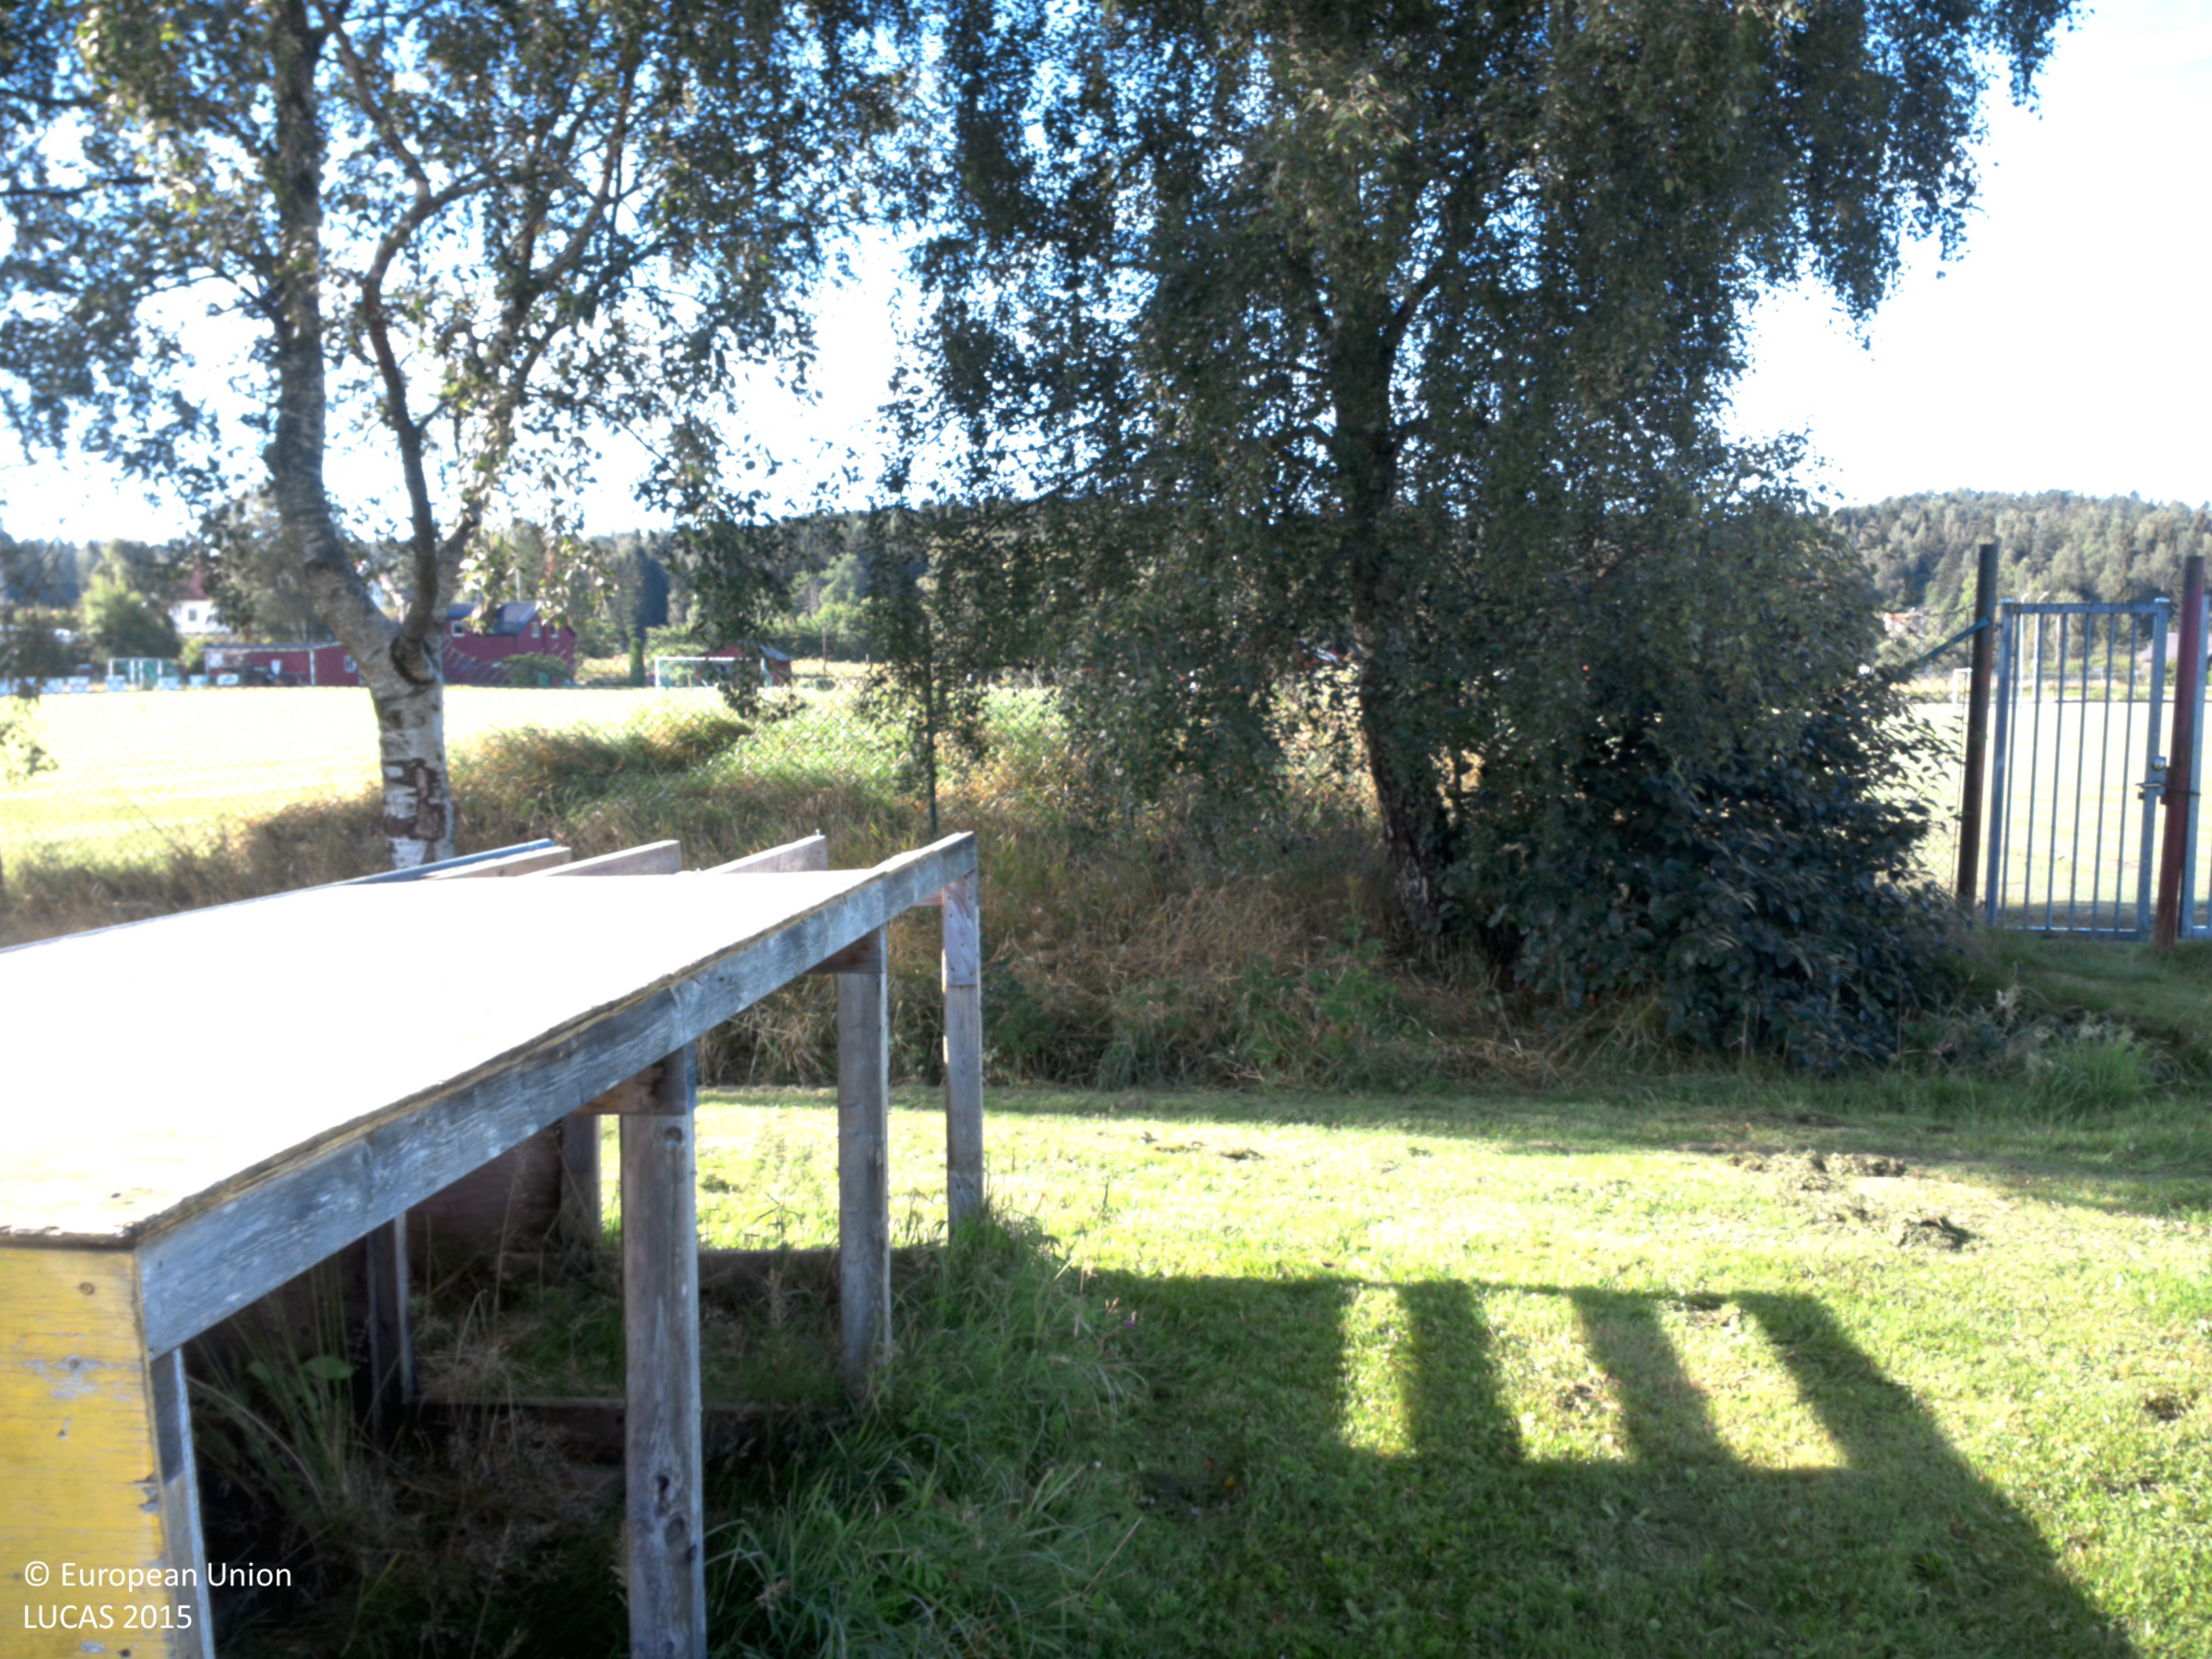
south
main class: Grassland
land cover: Grassland without tree/shrub cover
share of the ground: > 75 %
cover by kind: herbaceous plants 100 %
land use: Sport
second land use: Amenities, museums, leisure
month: August
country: SE
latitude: 58.0573
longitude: 12.2160
